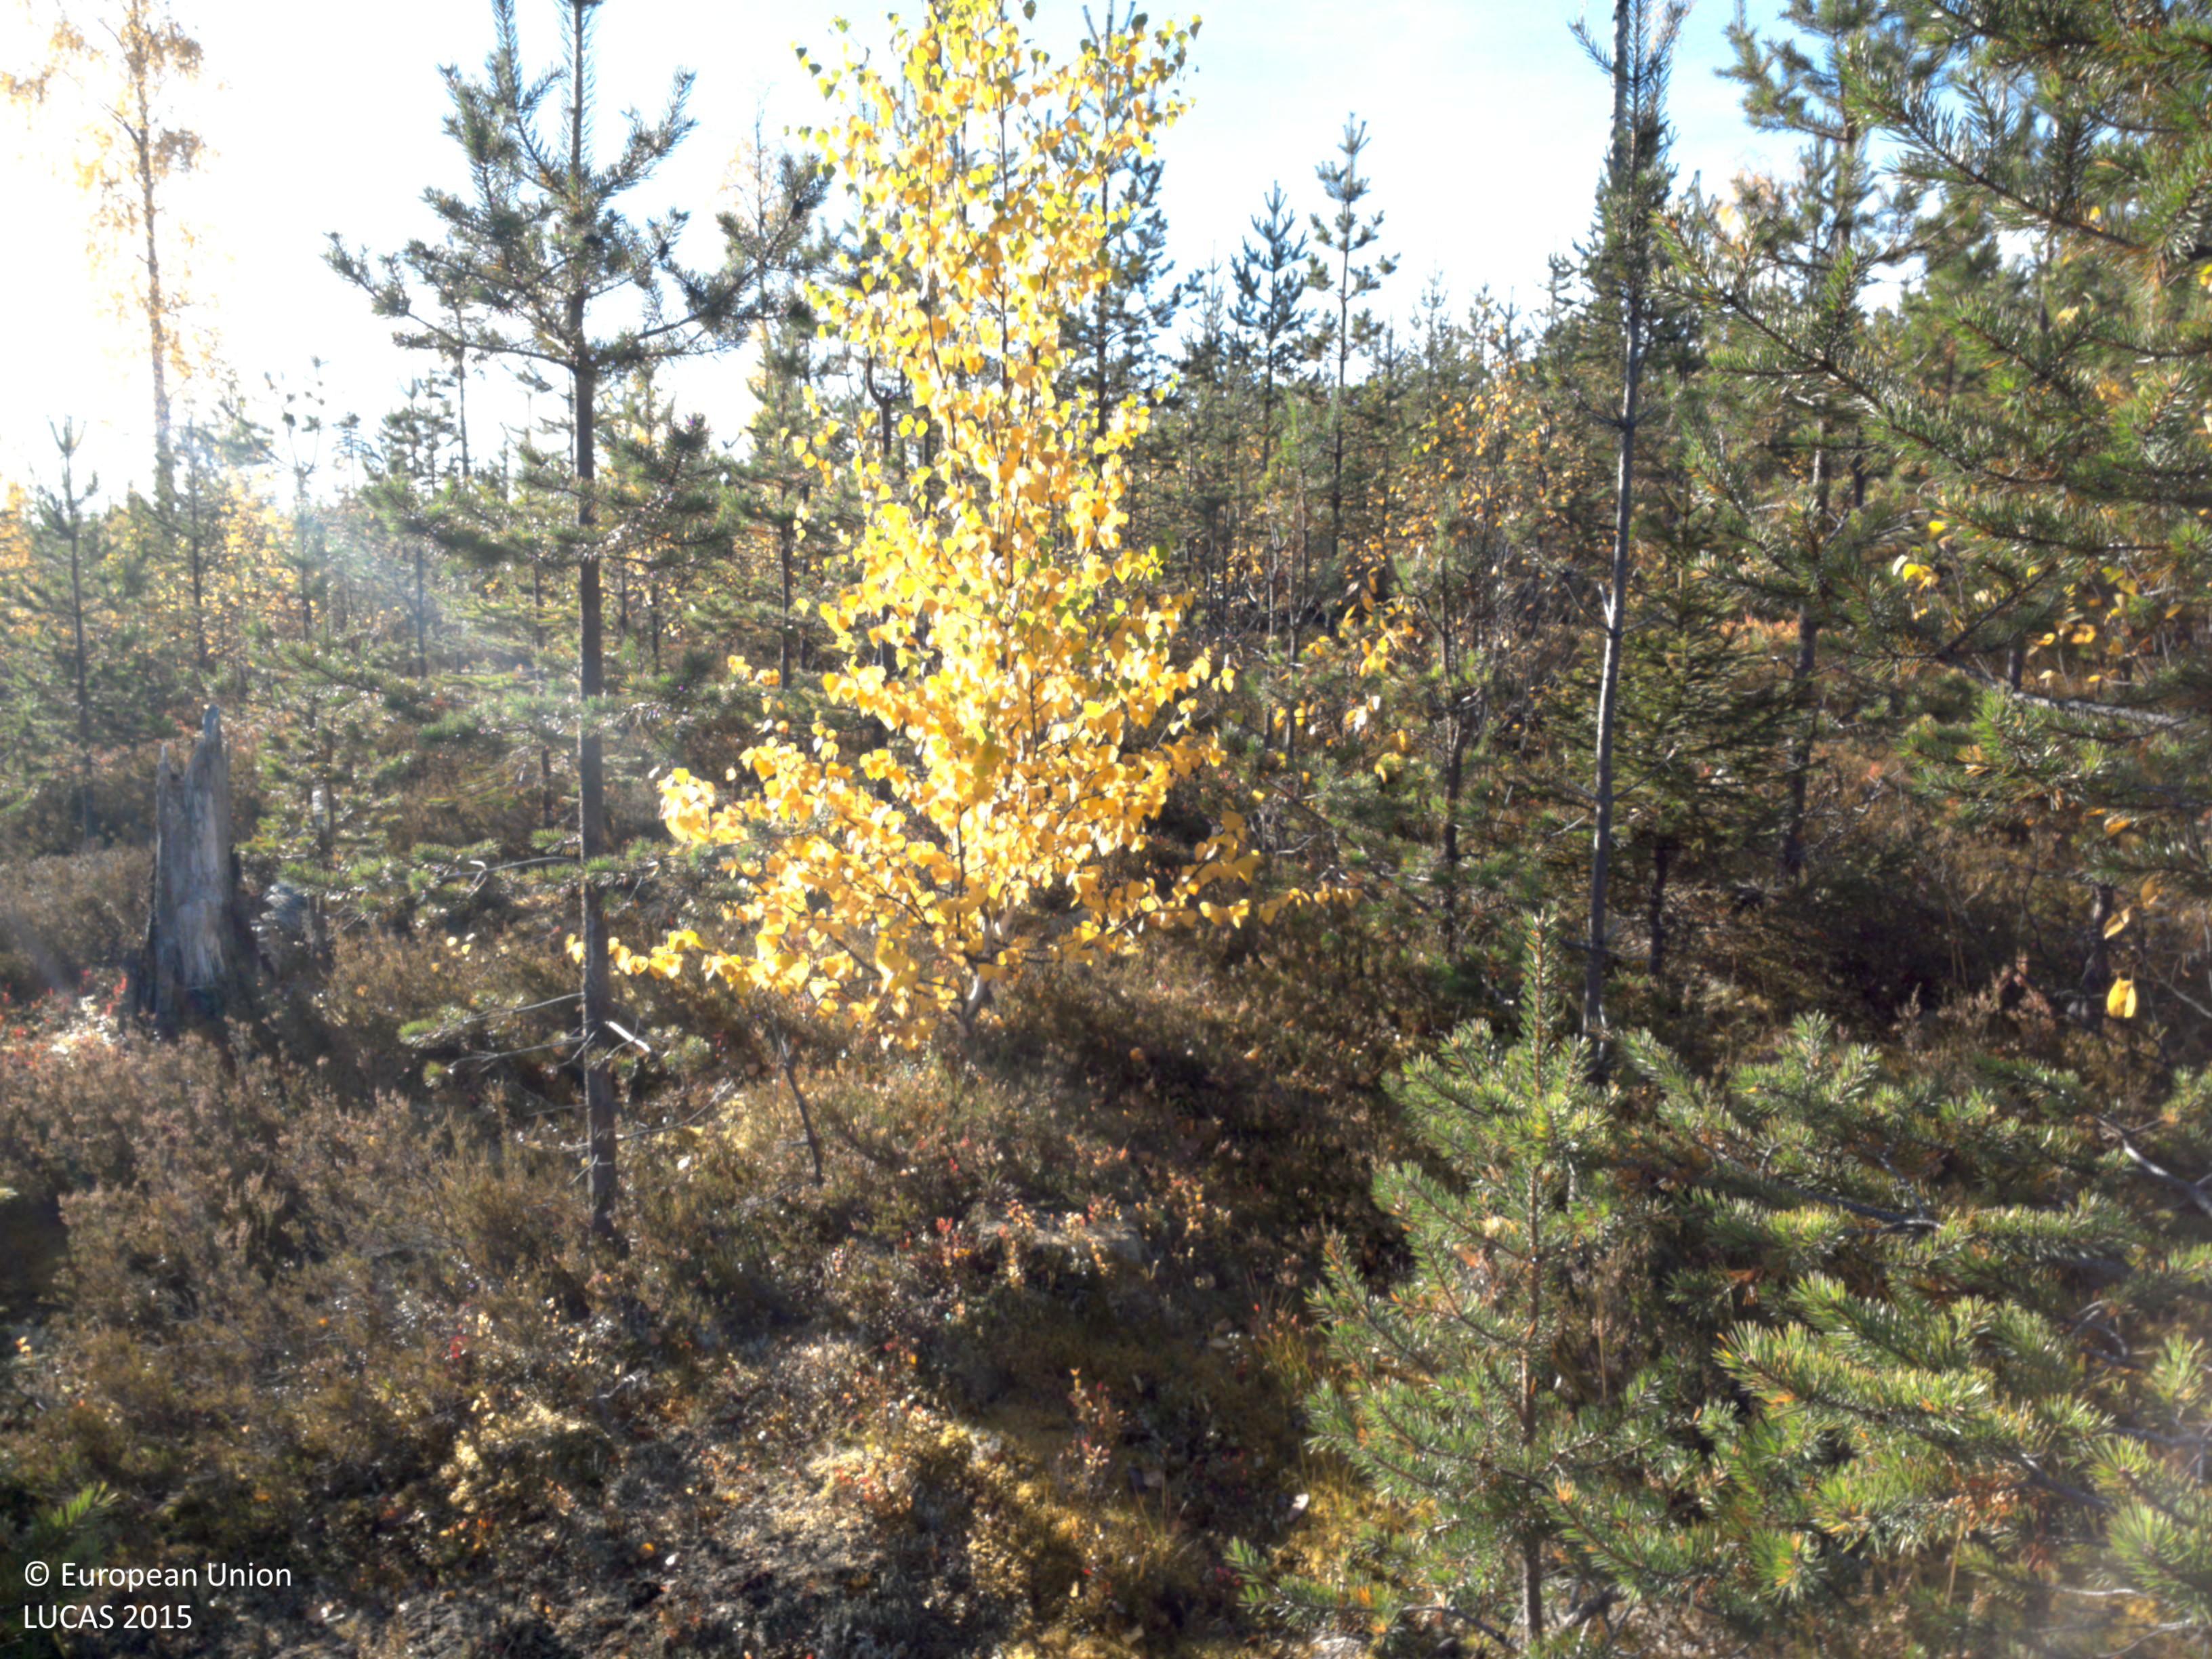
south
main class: Woodland
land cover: Pine dominated coniferous woodland
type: exotic forest
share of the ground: 50 - 75 %
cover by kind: coniferous forest trees 50 %, shrubs 30 %, broadleaved forest trees 10 %, herbaceous plants 5 %, lichens and mosses 5 %
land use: Forestry
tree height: < 5 m
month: September
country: SE
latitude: 64.8850
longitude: 18.3903
